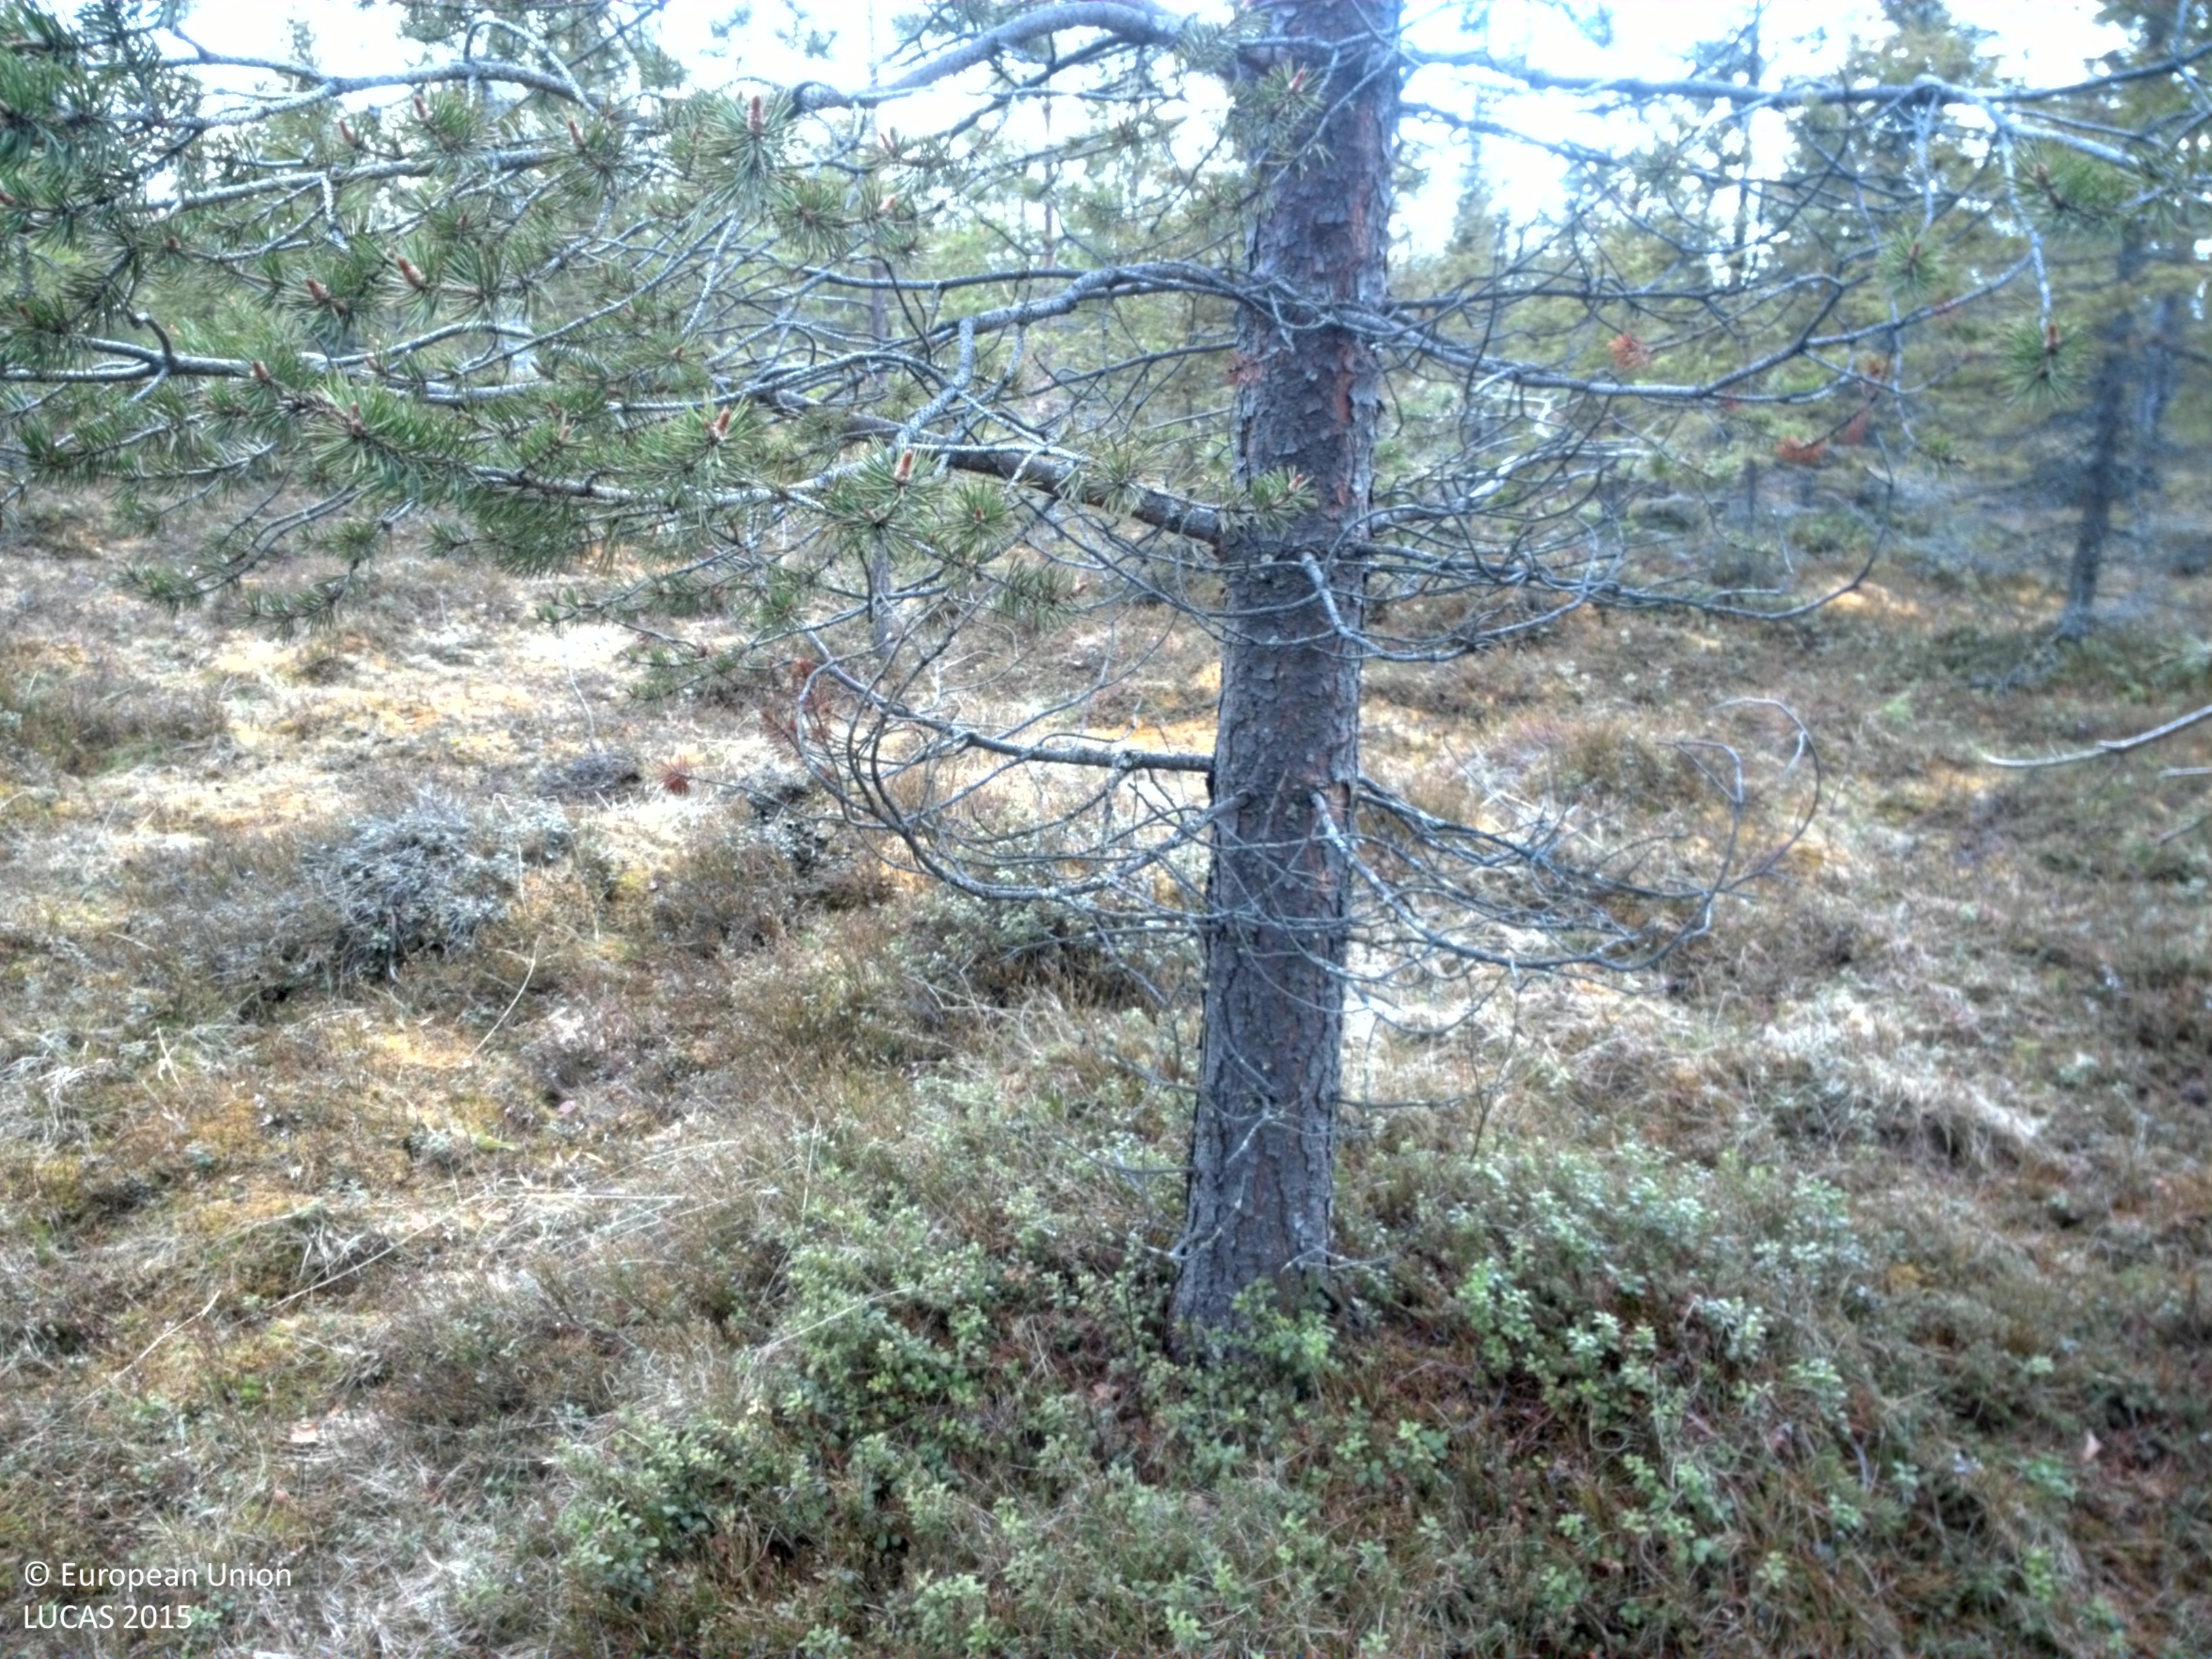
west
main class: Woodland
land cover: Other coniferous woodland
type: boreal forest
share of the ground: 50 - 75 %
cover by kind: coniferous forest trees 75 %, lichens and mosses 15 %, shrubs 10 %
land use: Forestry
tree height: > 5 m
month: June
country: SE
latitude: 66.9059
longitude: 20.9888
